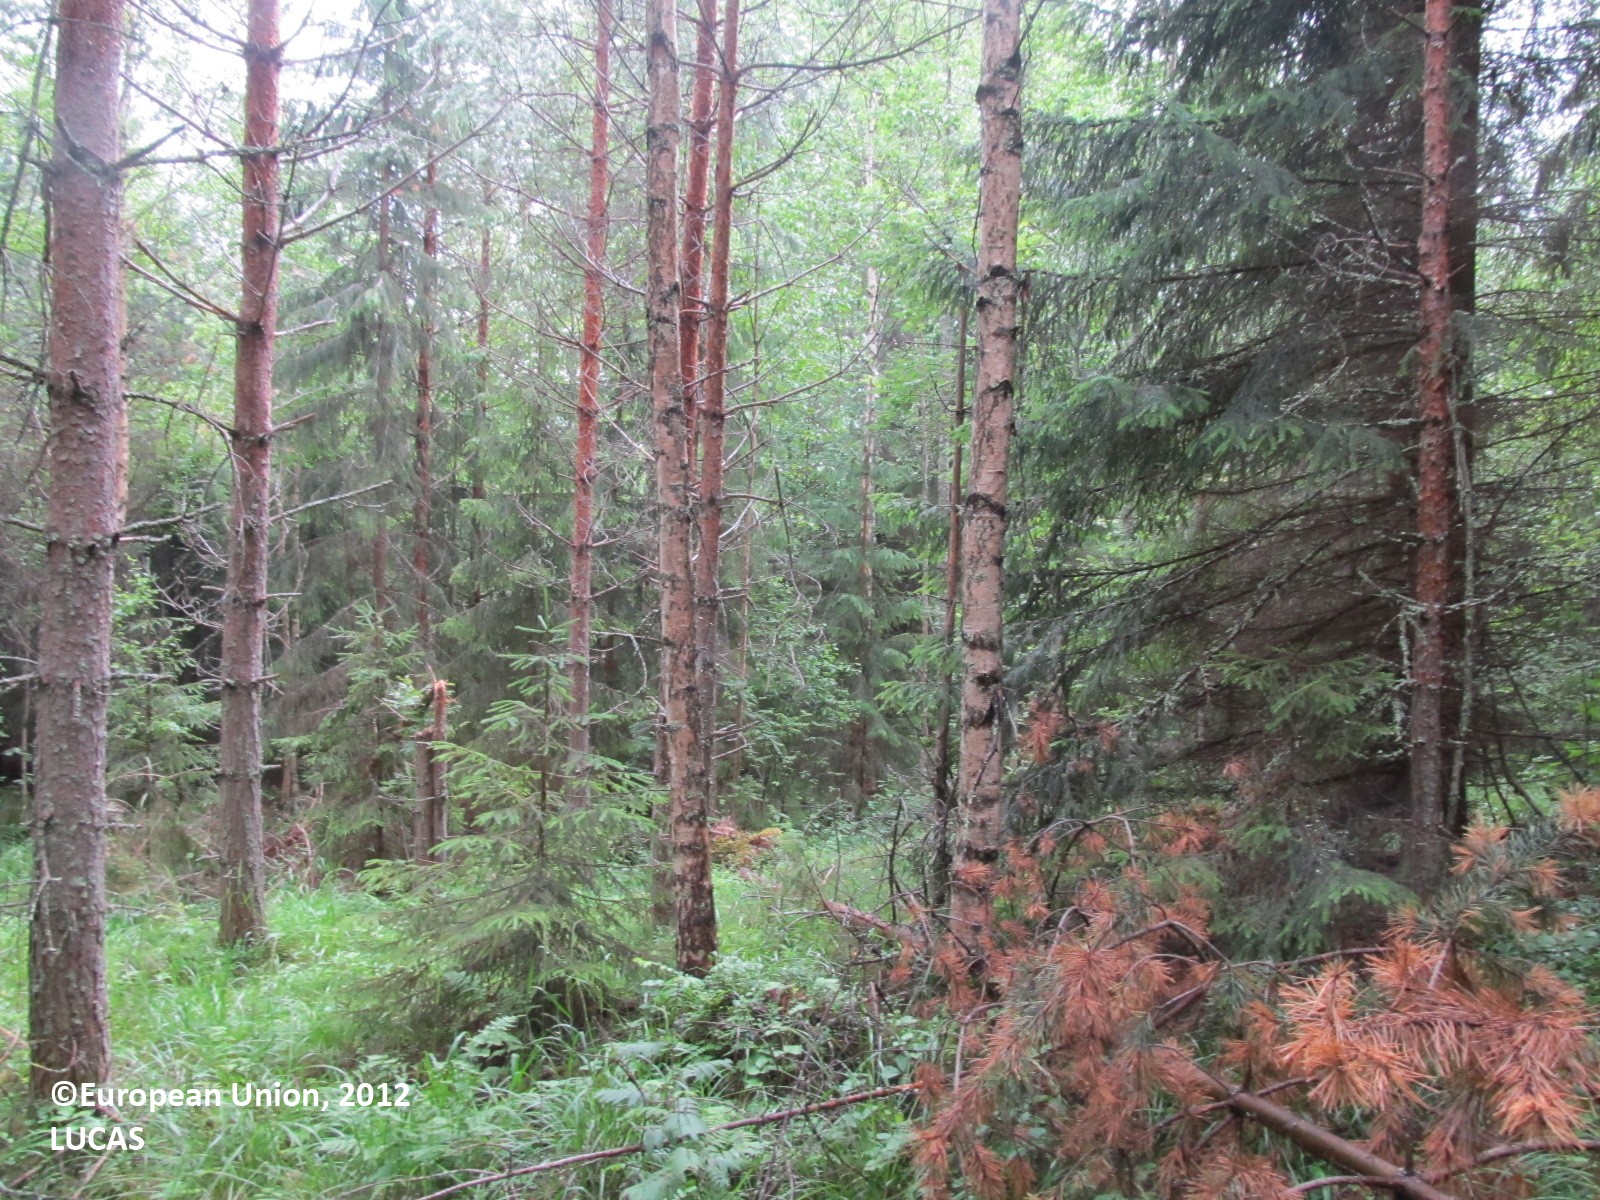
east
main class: Woodland
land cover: Spruce dominated mixed woodland
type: boreal forest
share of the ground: 25 - 50 %
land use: Forestry
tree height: > 5 m
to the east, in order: Spruce dominated mixed woodland; Tracks; Pine dominated mixed woodland
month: July
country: FI
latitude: 61.8618
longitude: 28.4737
